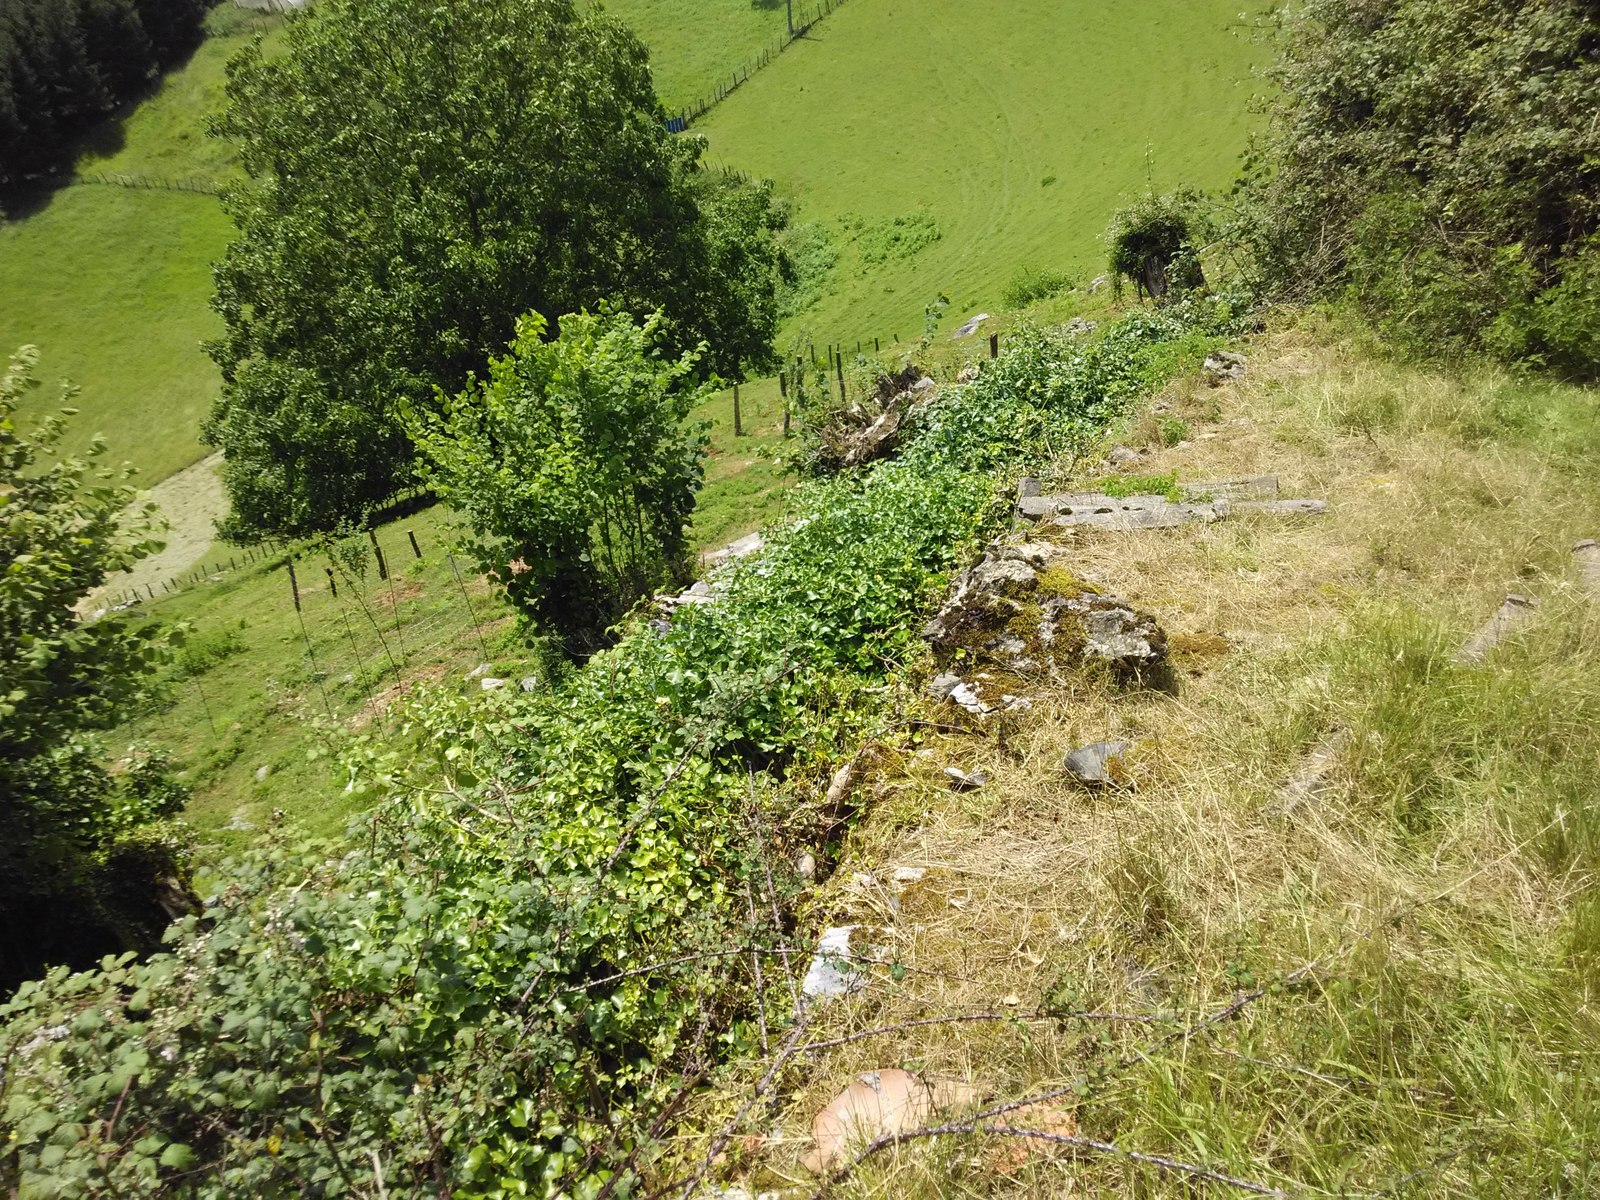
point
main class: Grassland
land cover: Grassland without tree/shrub cover
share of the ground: > 75 %
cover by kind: herbaceous plants 100 %
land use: Agriculture (excluding fallow land and kitchen gardens)
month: July
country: ES
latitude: 43.1852
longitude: -2.2421
